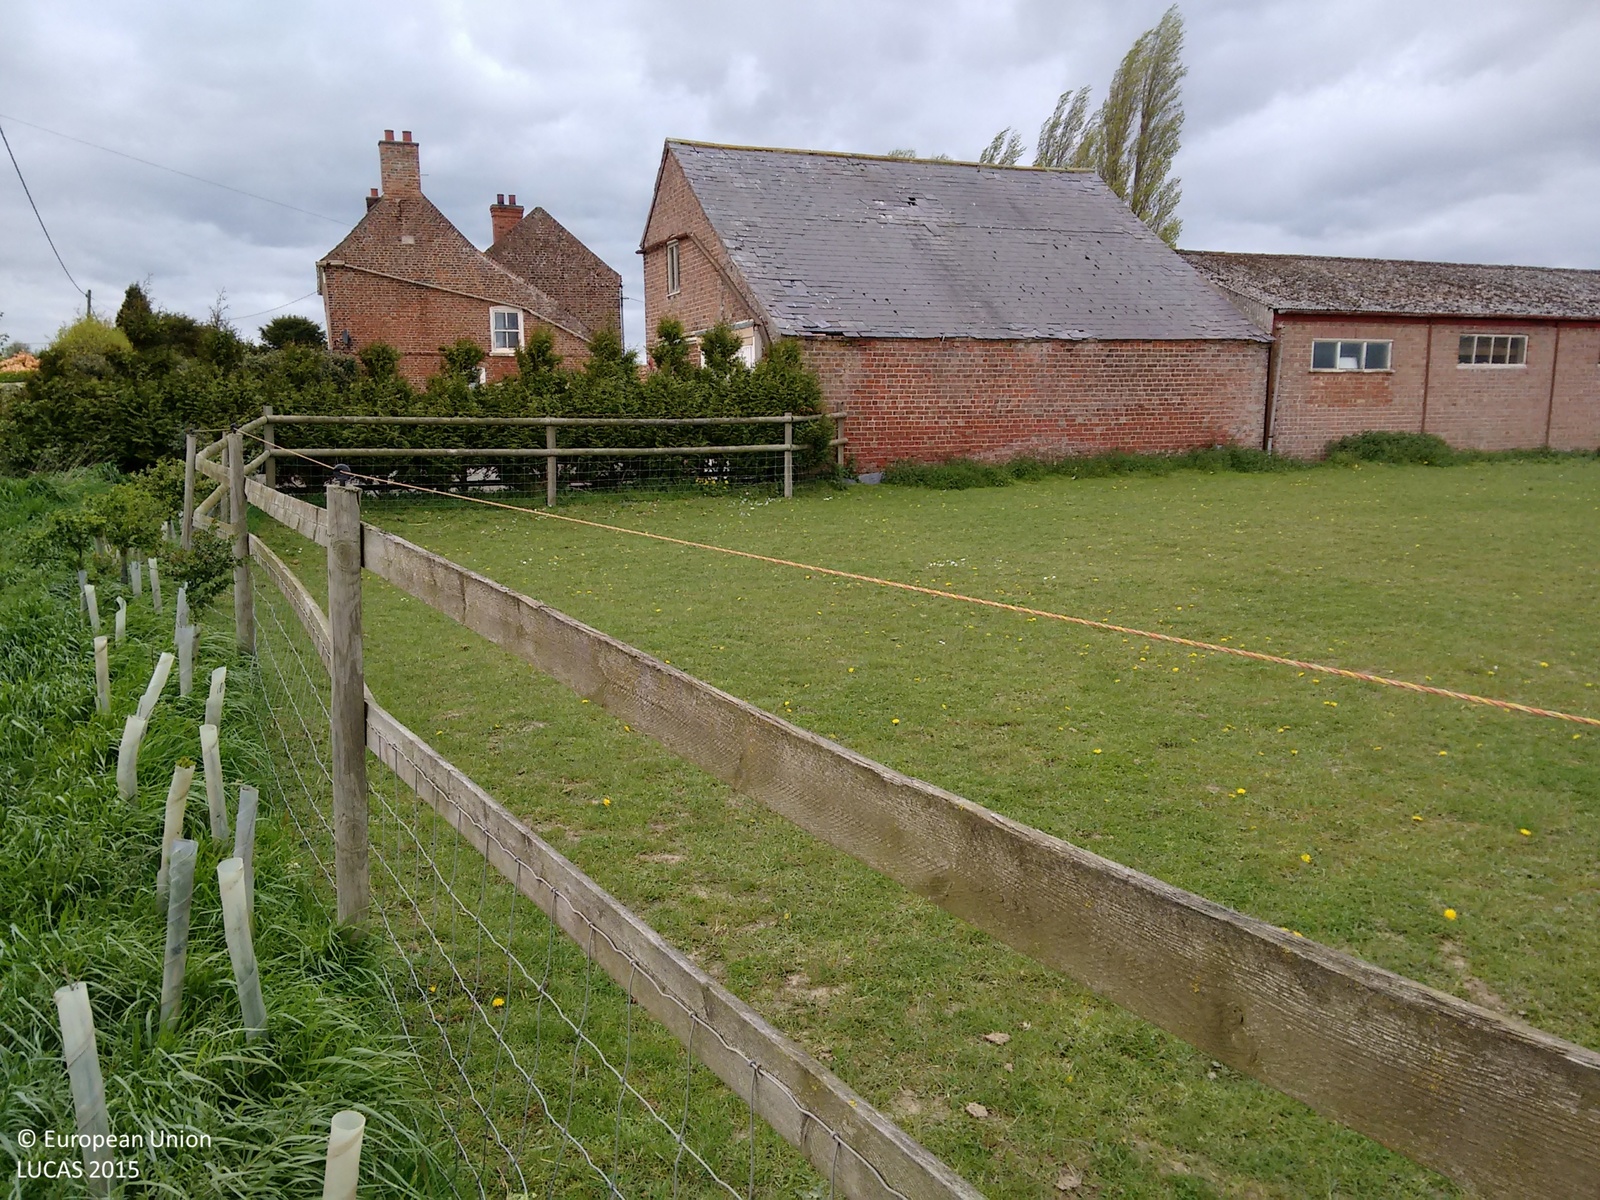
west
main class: Grassland
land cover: Grassland without tree/shrub cover
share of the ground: > 75 %
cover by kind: herbaceous plants 100 %
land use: Agriculture (excluding fallow land and kitchen gardens)
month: May
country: GB
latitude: 52.9921
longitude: 0.0614
